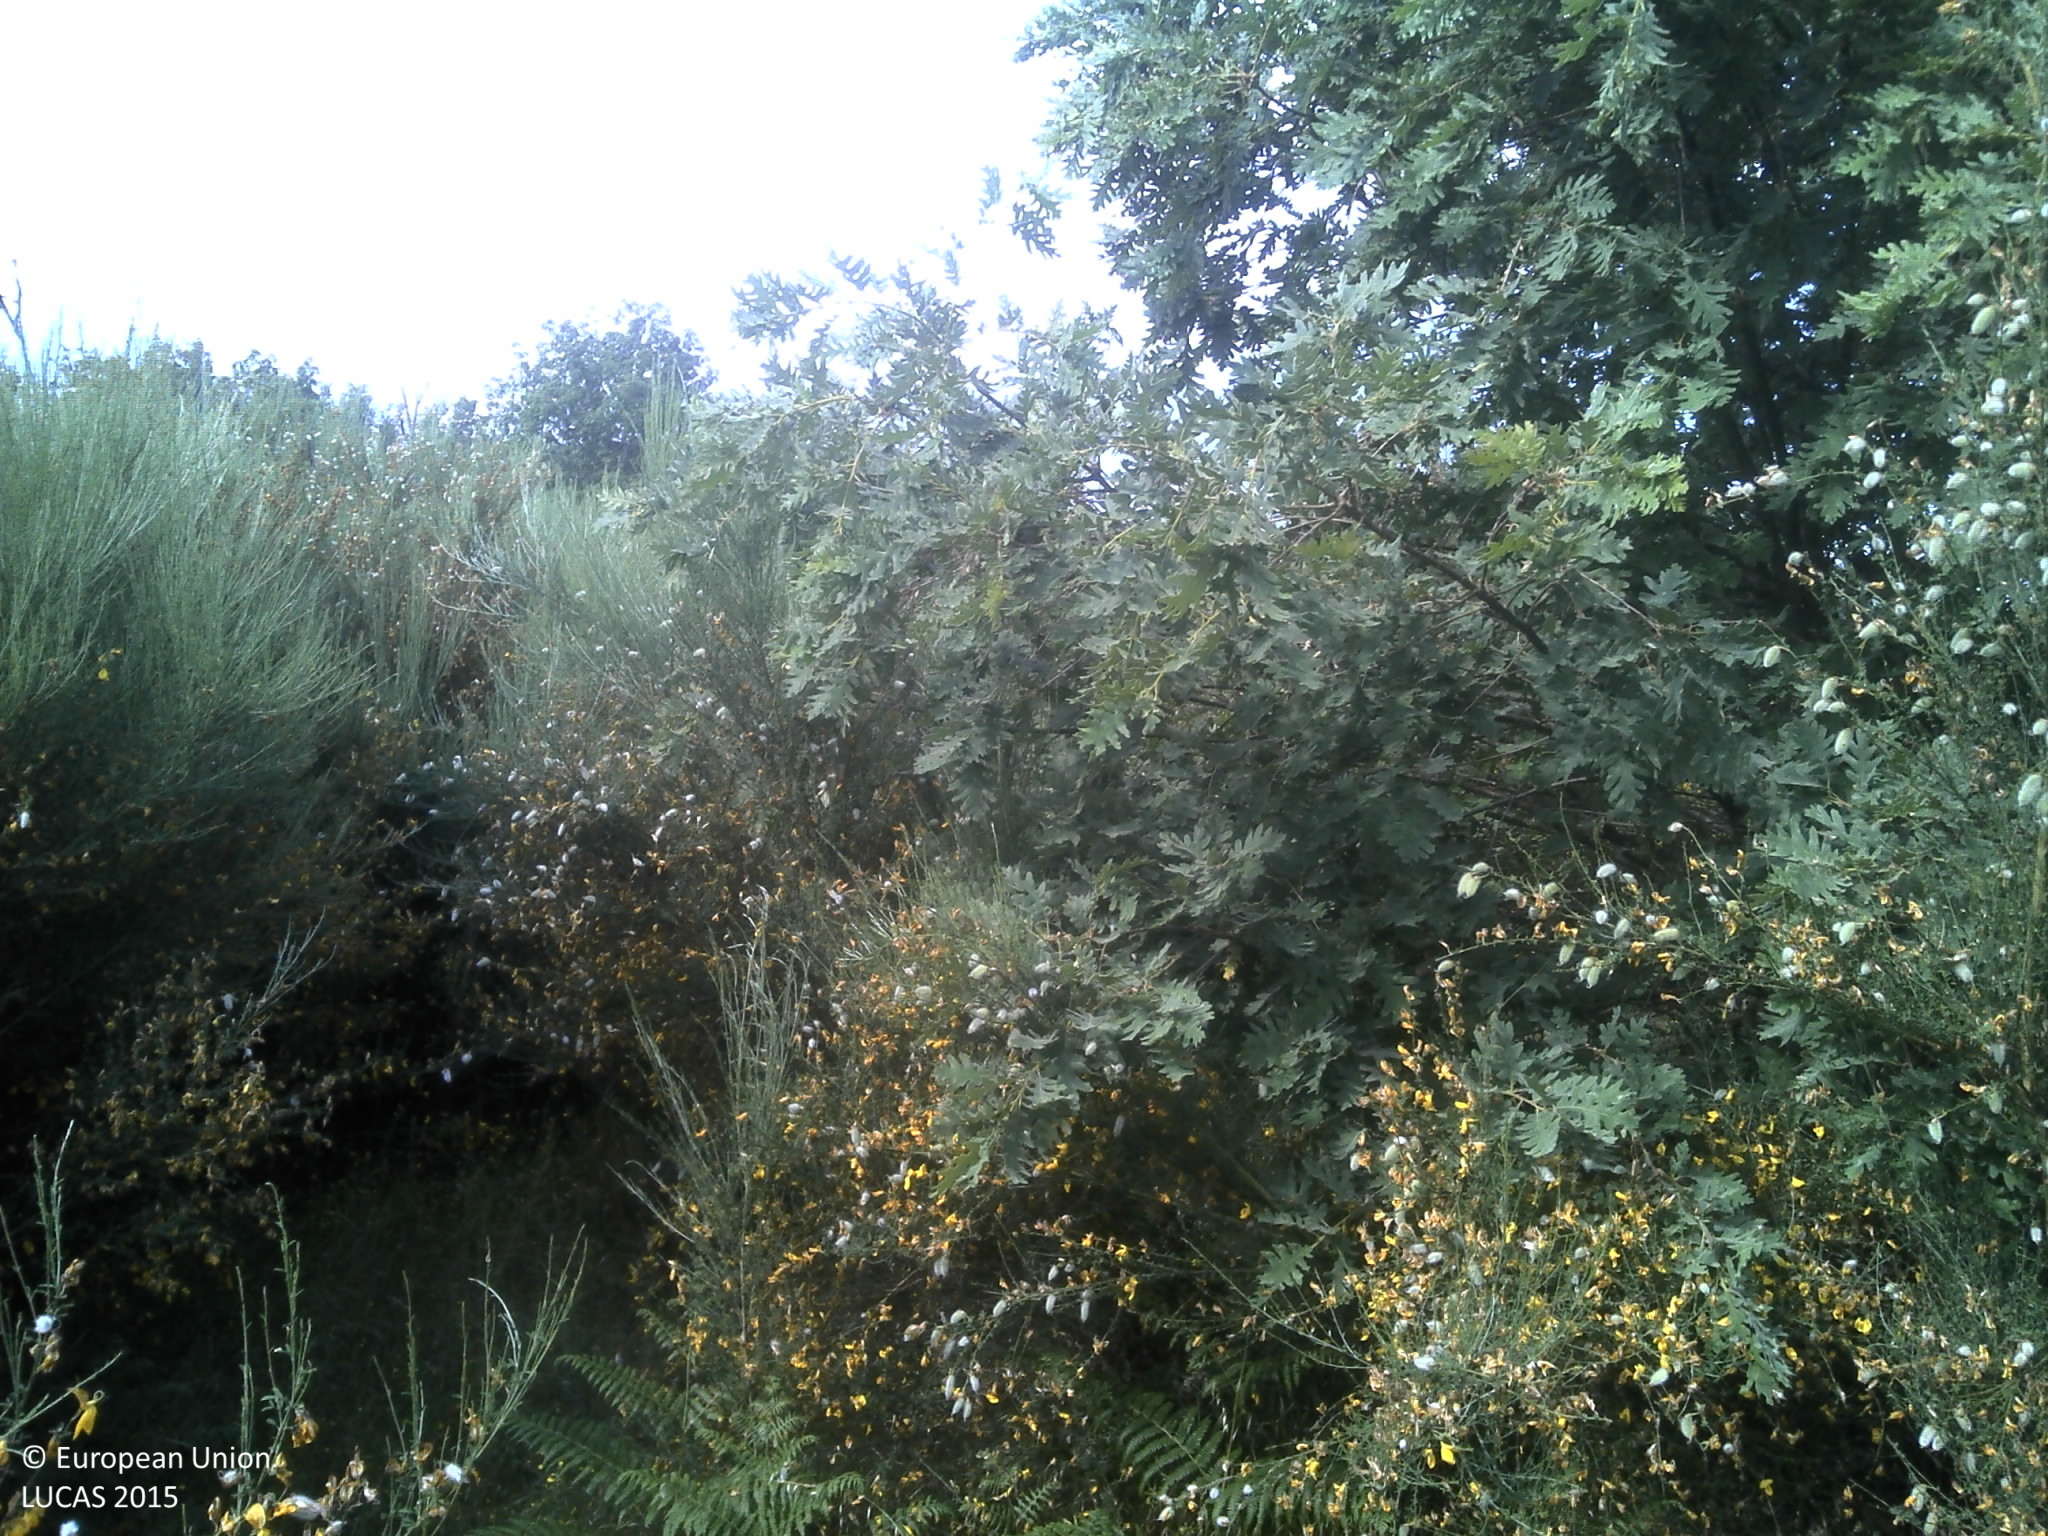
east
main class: Shrubland
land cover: Shrubland with sparse tree cover
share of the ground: 50 - 75 %
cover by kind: shrubs 75 %, unconsolidated bare surface 10 %, broadleaved forest trees 5 %, herbaceous plants 5 %
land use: Abandoned areas
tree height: < 5 m
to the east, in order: Shrubland with sparse tree cover; Spontaneously vegetated surfaces; Grass margins; Grassland without tree/shrub cover; Abandoned hedges; Dry stone walls; Artificial constructions in urban areas; Broadleaved woodland; Fences; Spontaneously vegetated surfaces; Artificial constructions in urban areas; Broadleaved woodland
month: June
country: PT
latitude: 40.3947
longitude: -7.1000
